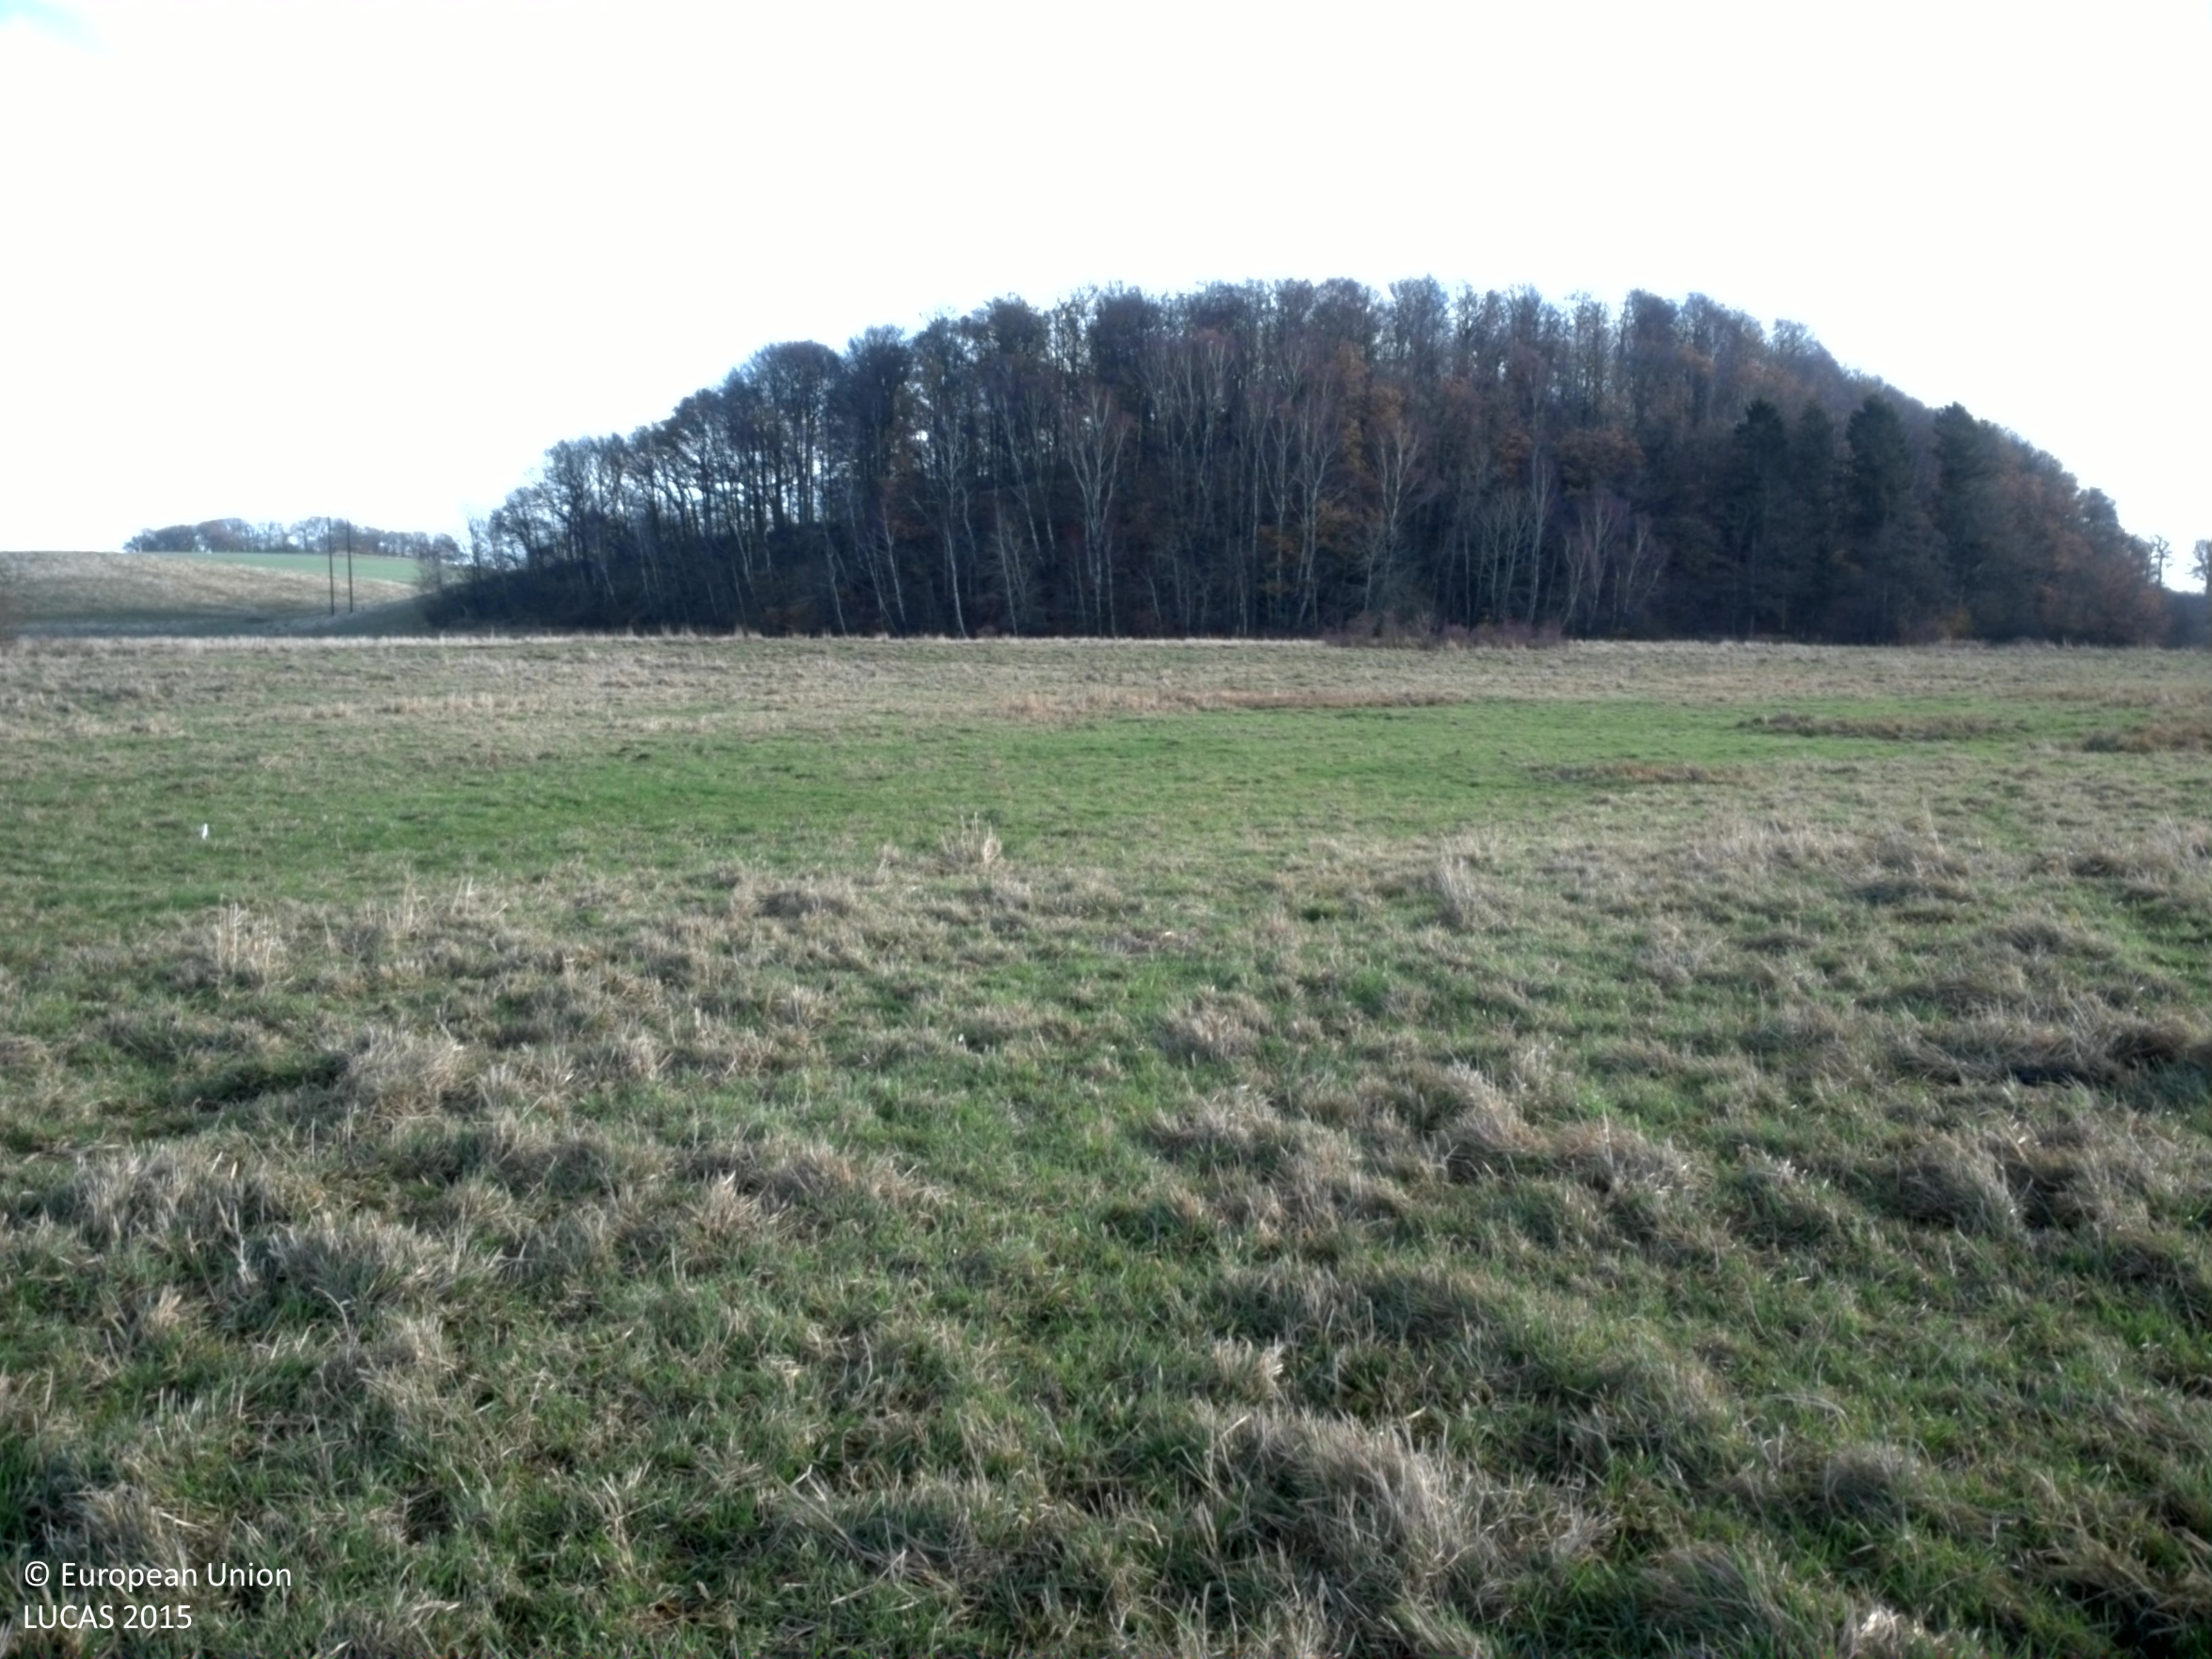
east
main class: Grassland
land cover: Grassland without tree/shrub cover
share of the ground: > 75 %
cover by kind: herbaceous plants 100 %
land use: Agriculture (excluding fallow land and kitchen gardens)
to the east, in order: Grassland without tree/shrub cover; Inland fresh running water; Grassland without tree/shrub cover; Fences; Broadleaved woodland
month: November
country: SE
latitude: 56.1510
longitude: 13.0721
